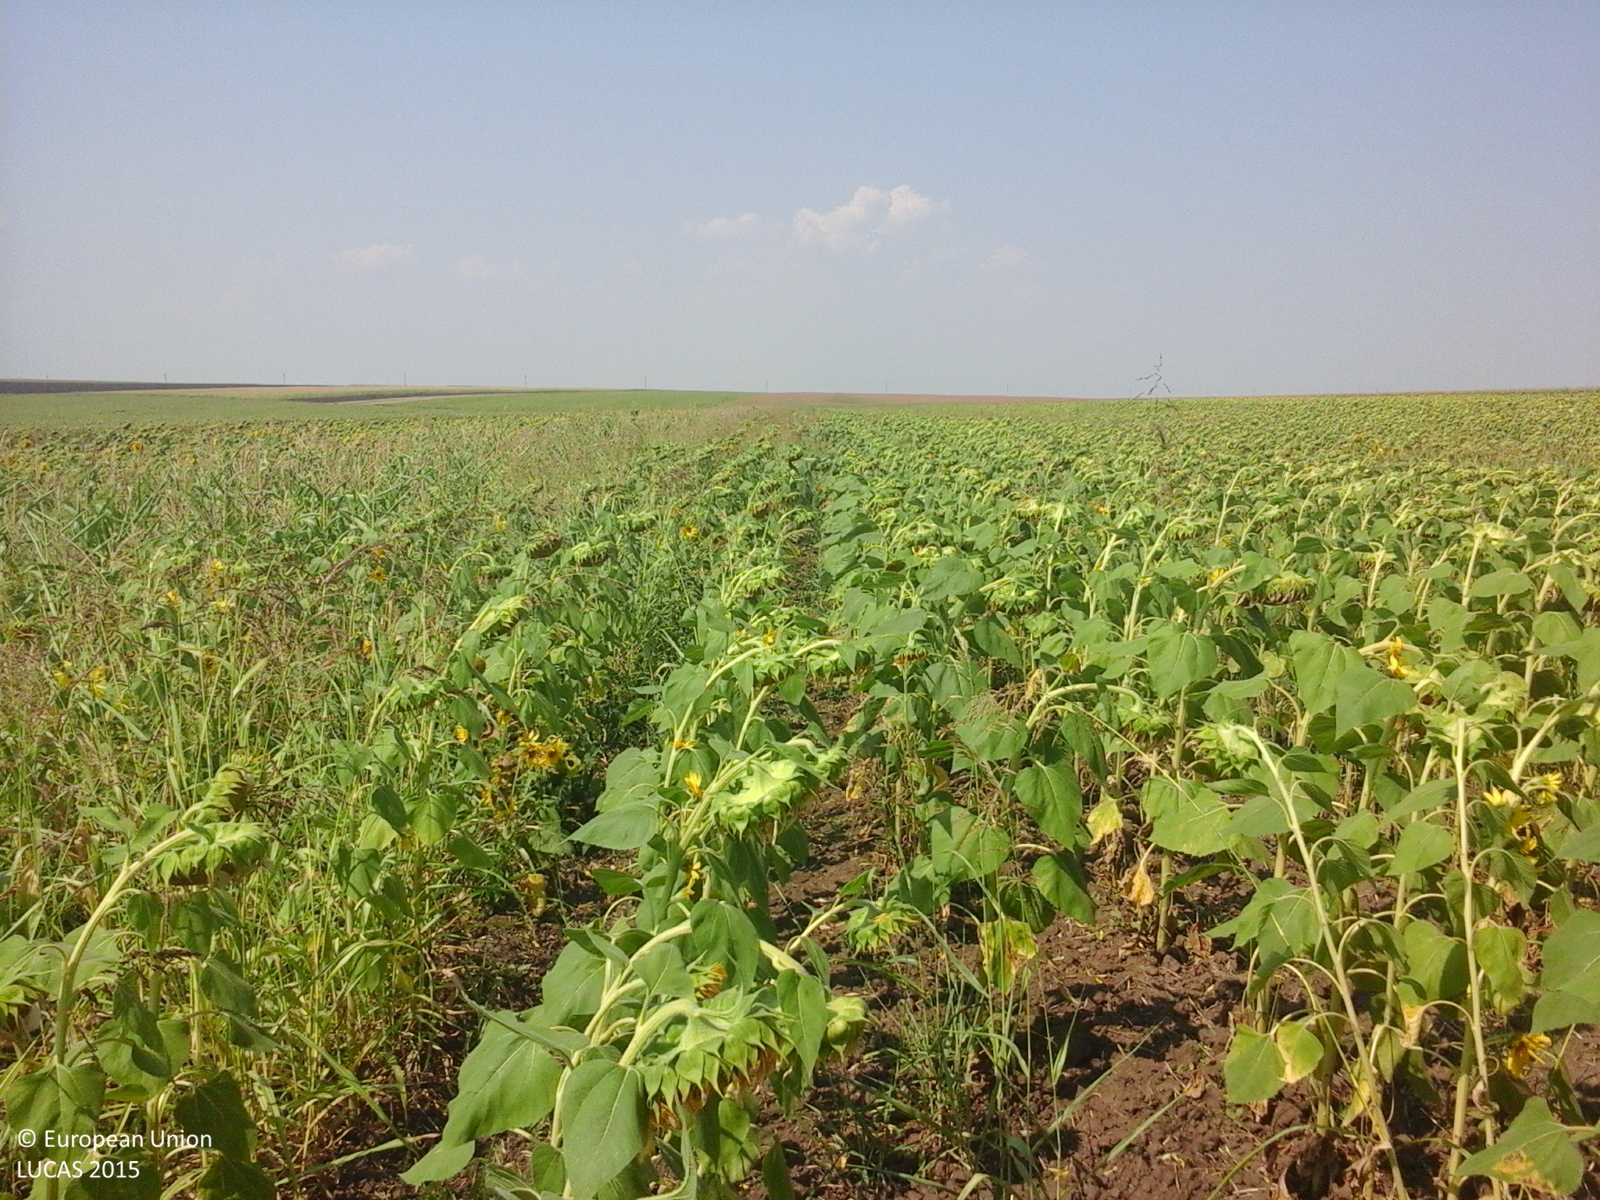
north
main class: Cropland
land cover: Sunflower
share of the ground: > 75 %
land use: Agriculture (excluding fallow land and kitchen gardens)
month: July
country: RO
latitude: 45.6259
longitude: 27.8529
